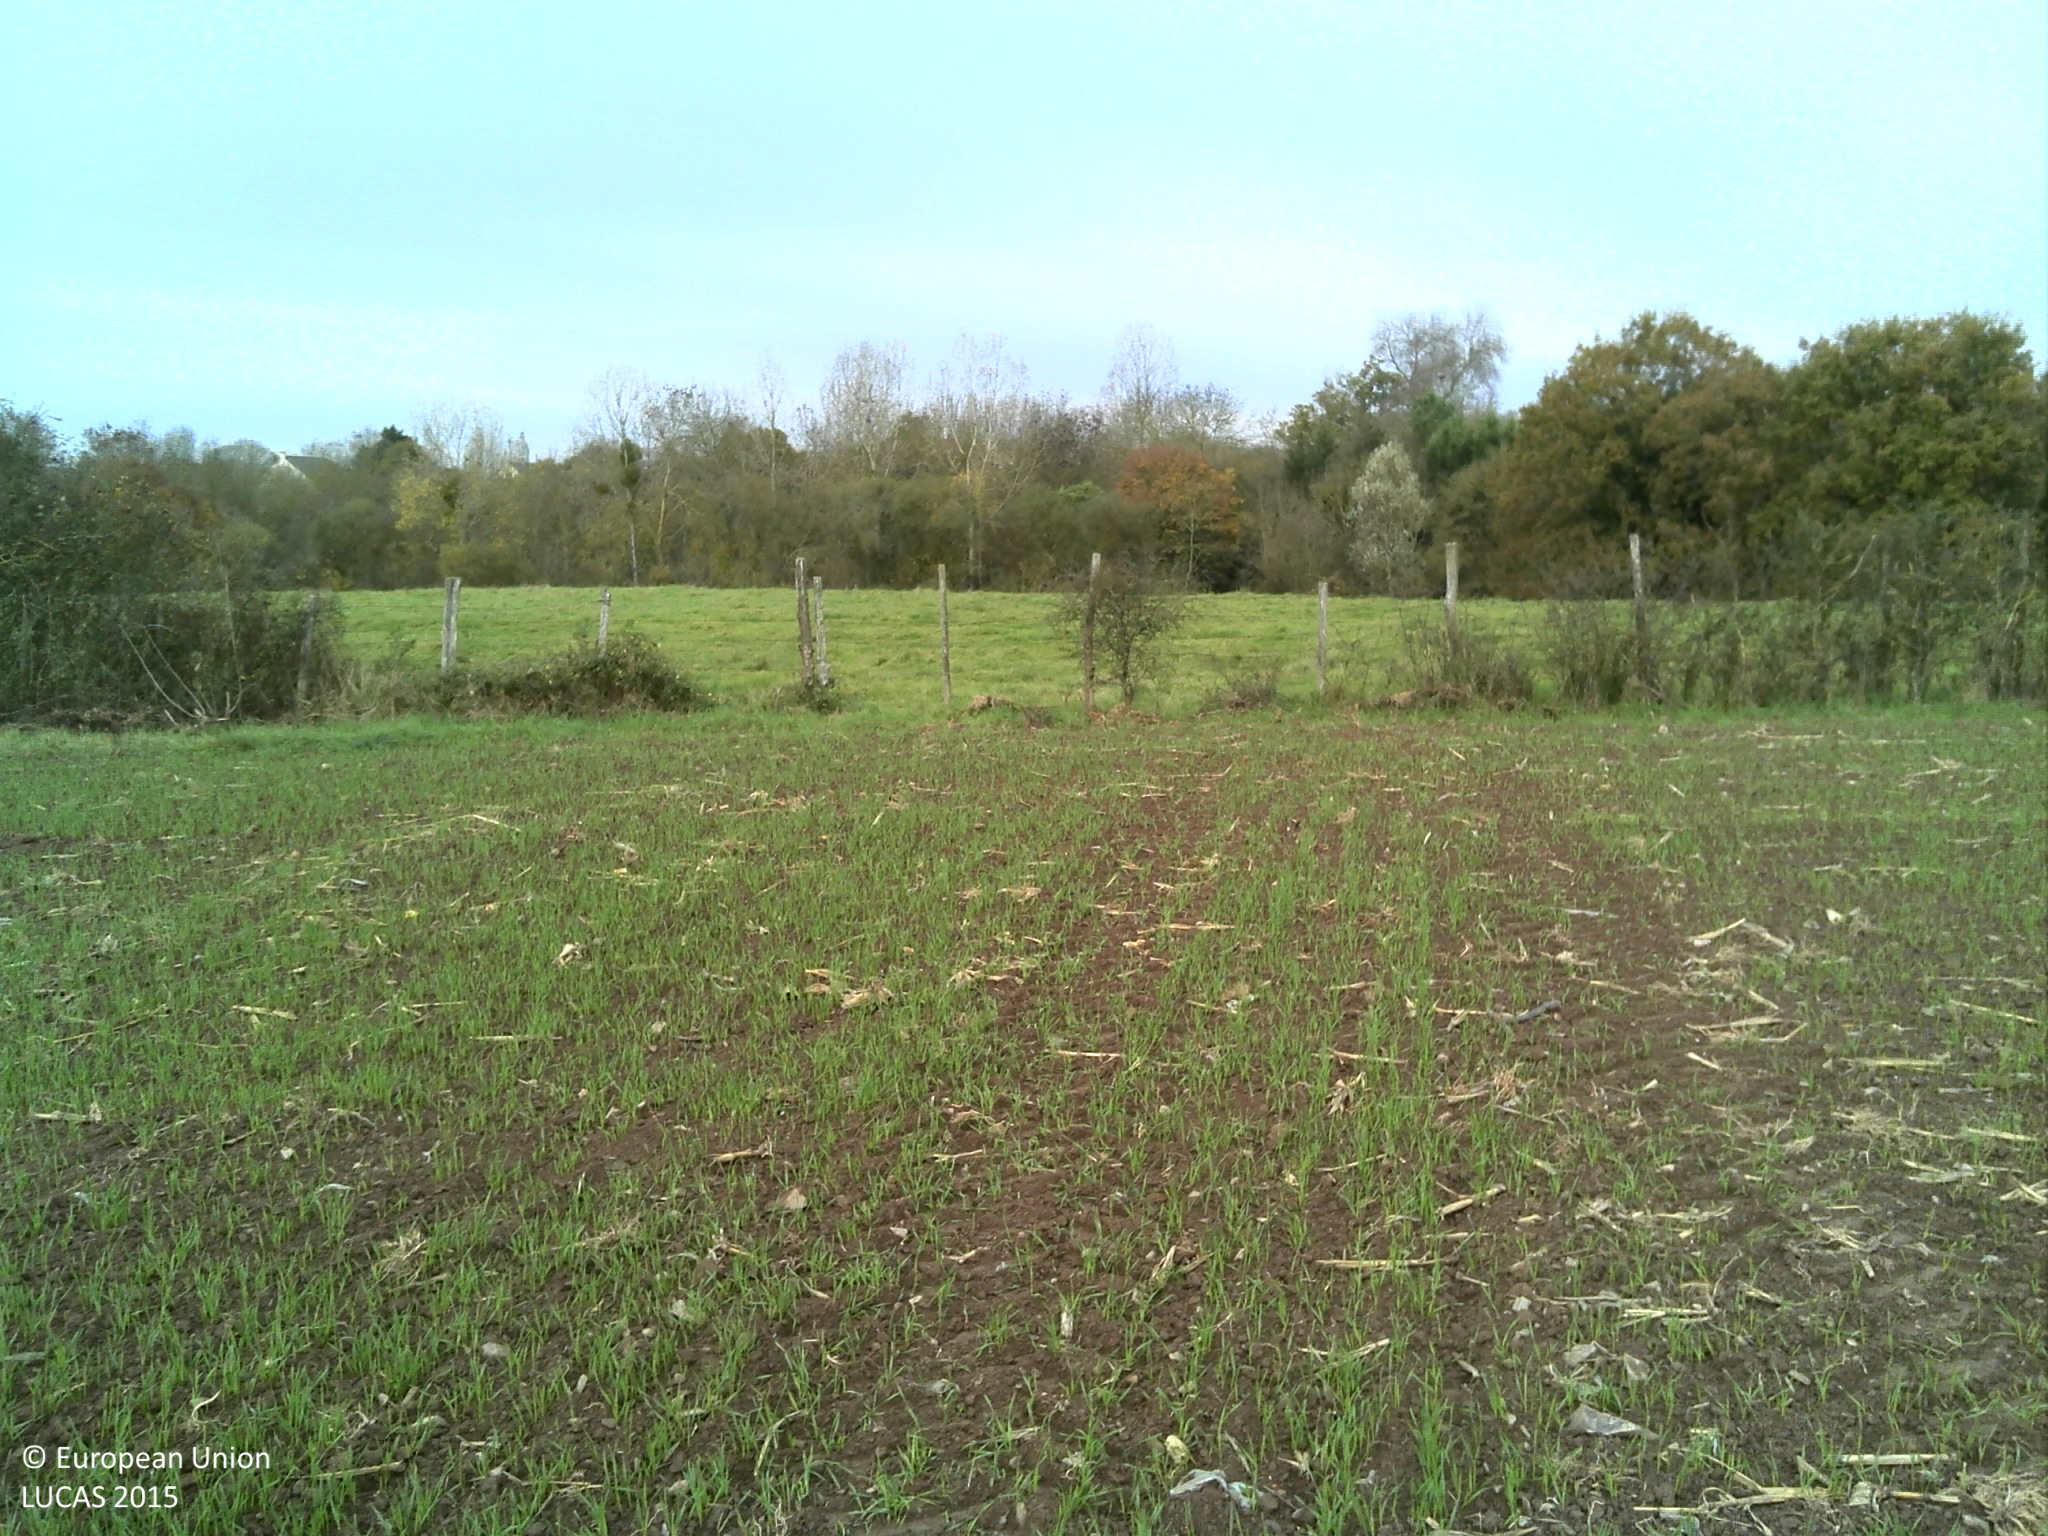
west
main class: Cropland
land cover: Common wheat
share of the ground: 25 - 50 %
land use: Agriculture (excluding fallow land and kitchen gardens)
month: November
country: FR
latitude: 47.4231
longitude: -1.2941
